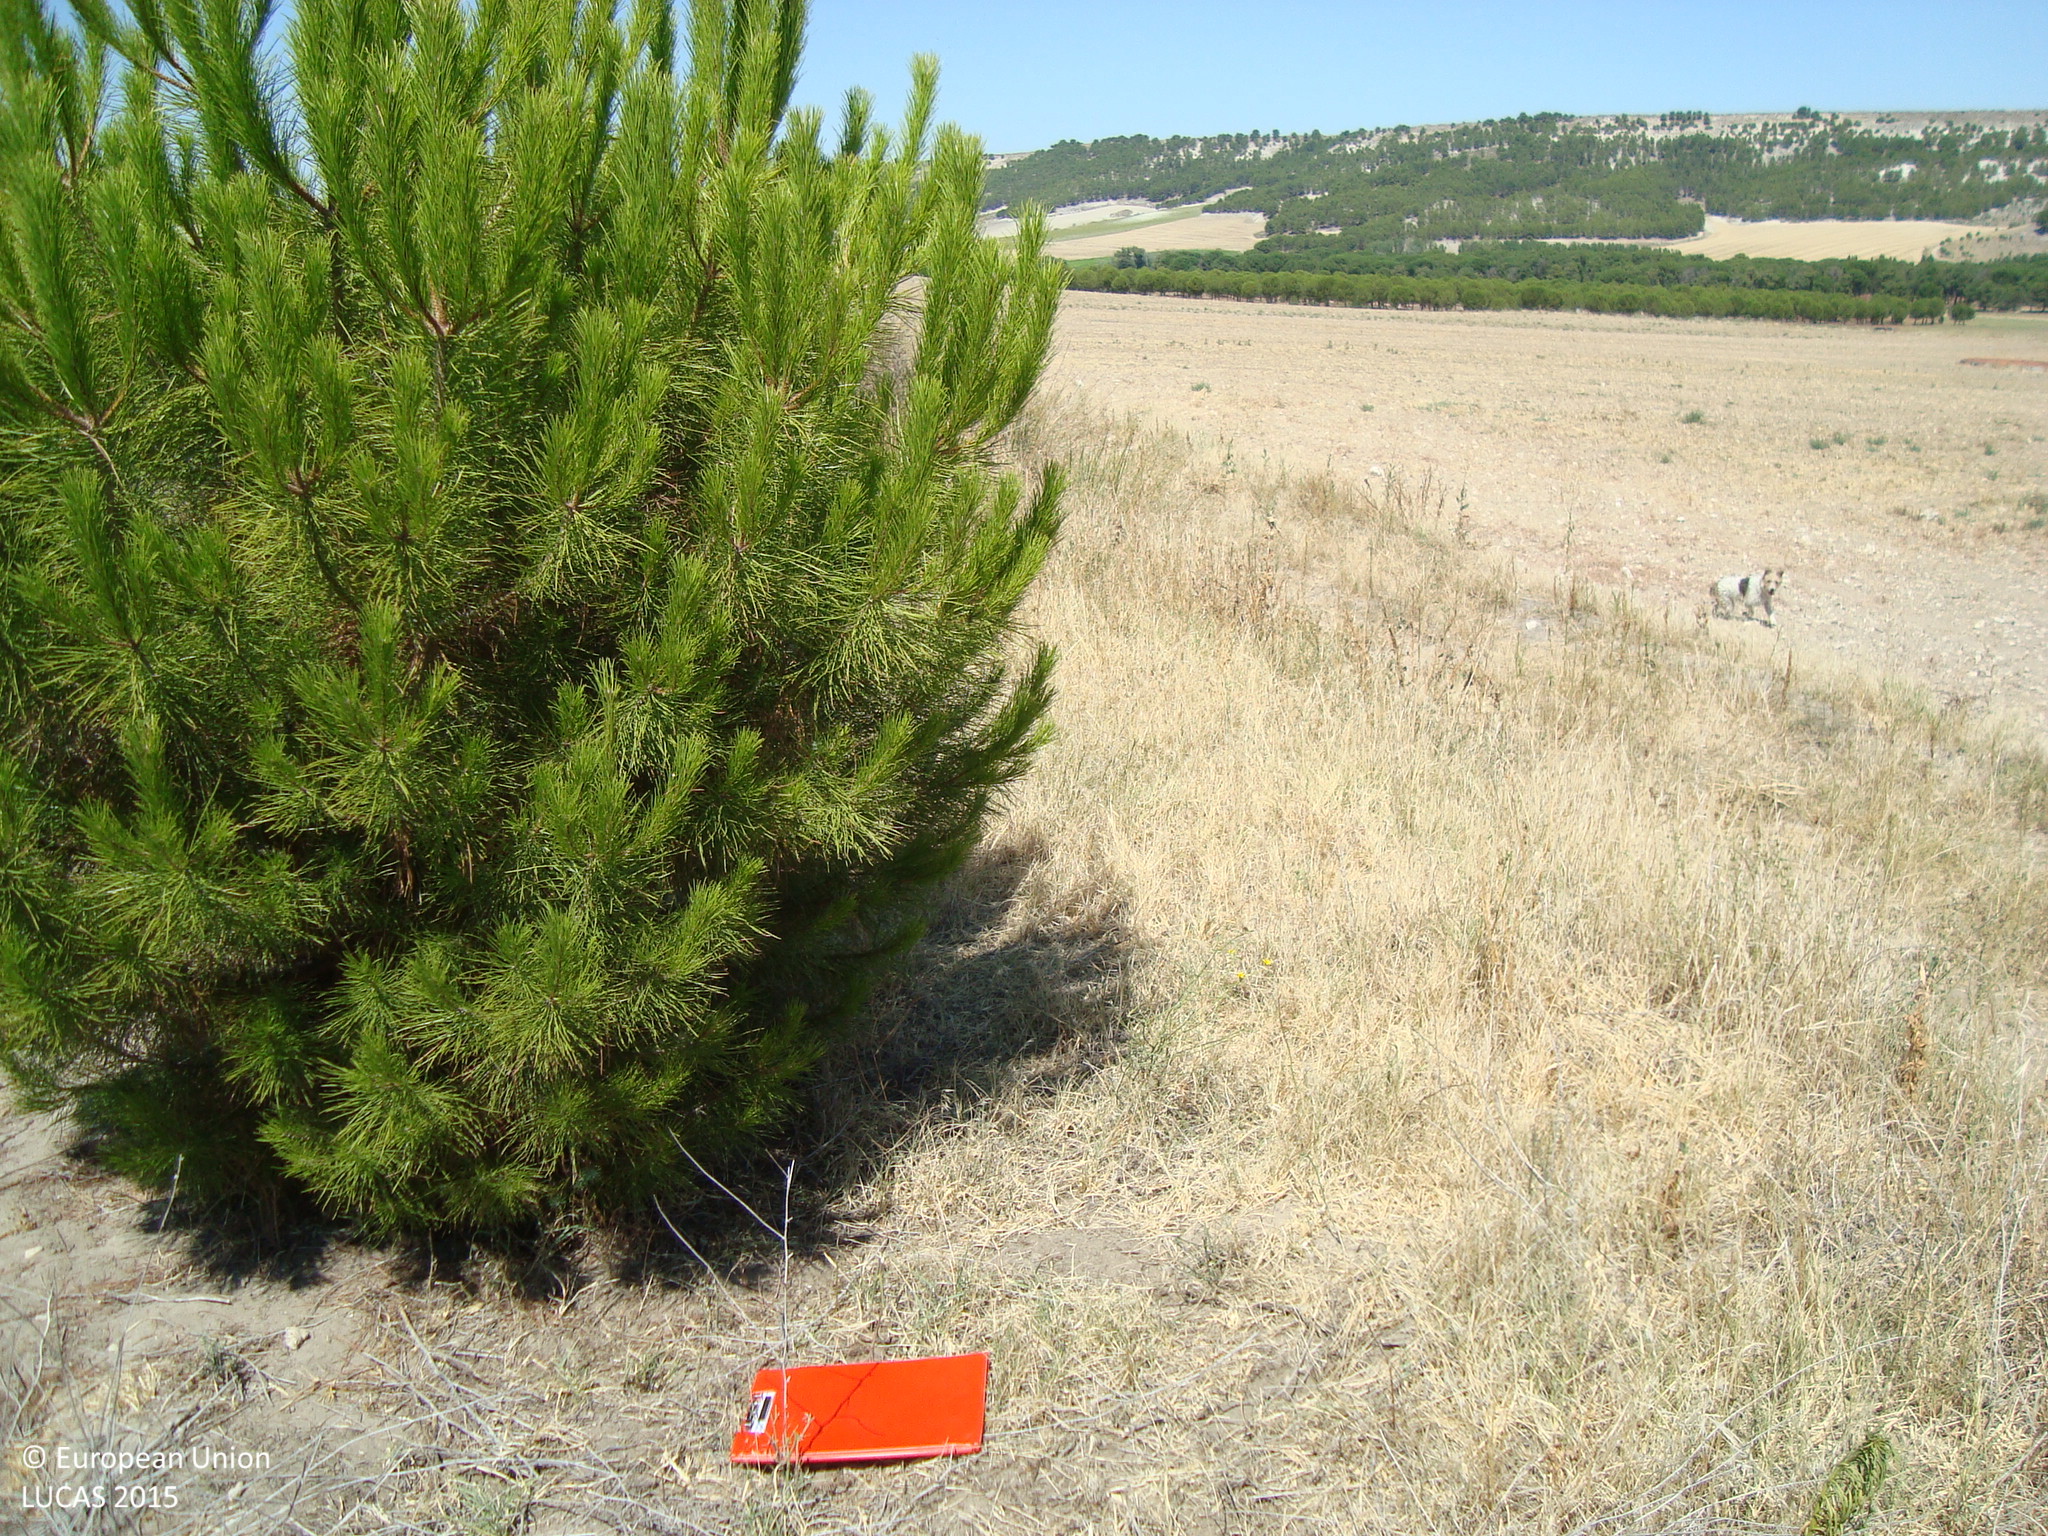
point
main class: Woodland
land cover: Pine dominated coniferous woodland
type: coniferous forest of the mediterranean region
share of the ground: 25 - 50 %
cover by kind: herbaceous plants 60 %, coniferous forest trees 40 %
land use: Forestry
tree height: < 5 m
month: August
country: ES
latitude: 41.4066
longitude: -4.5980
